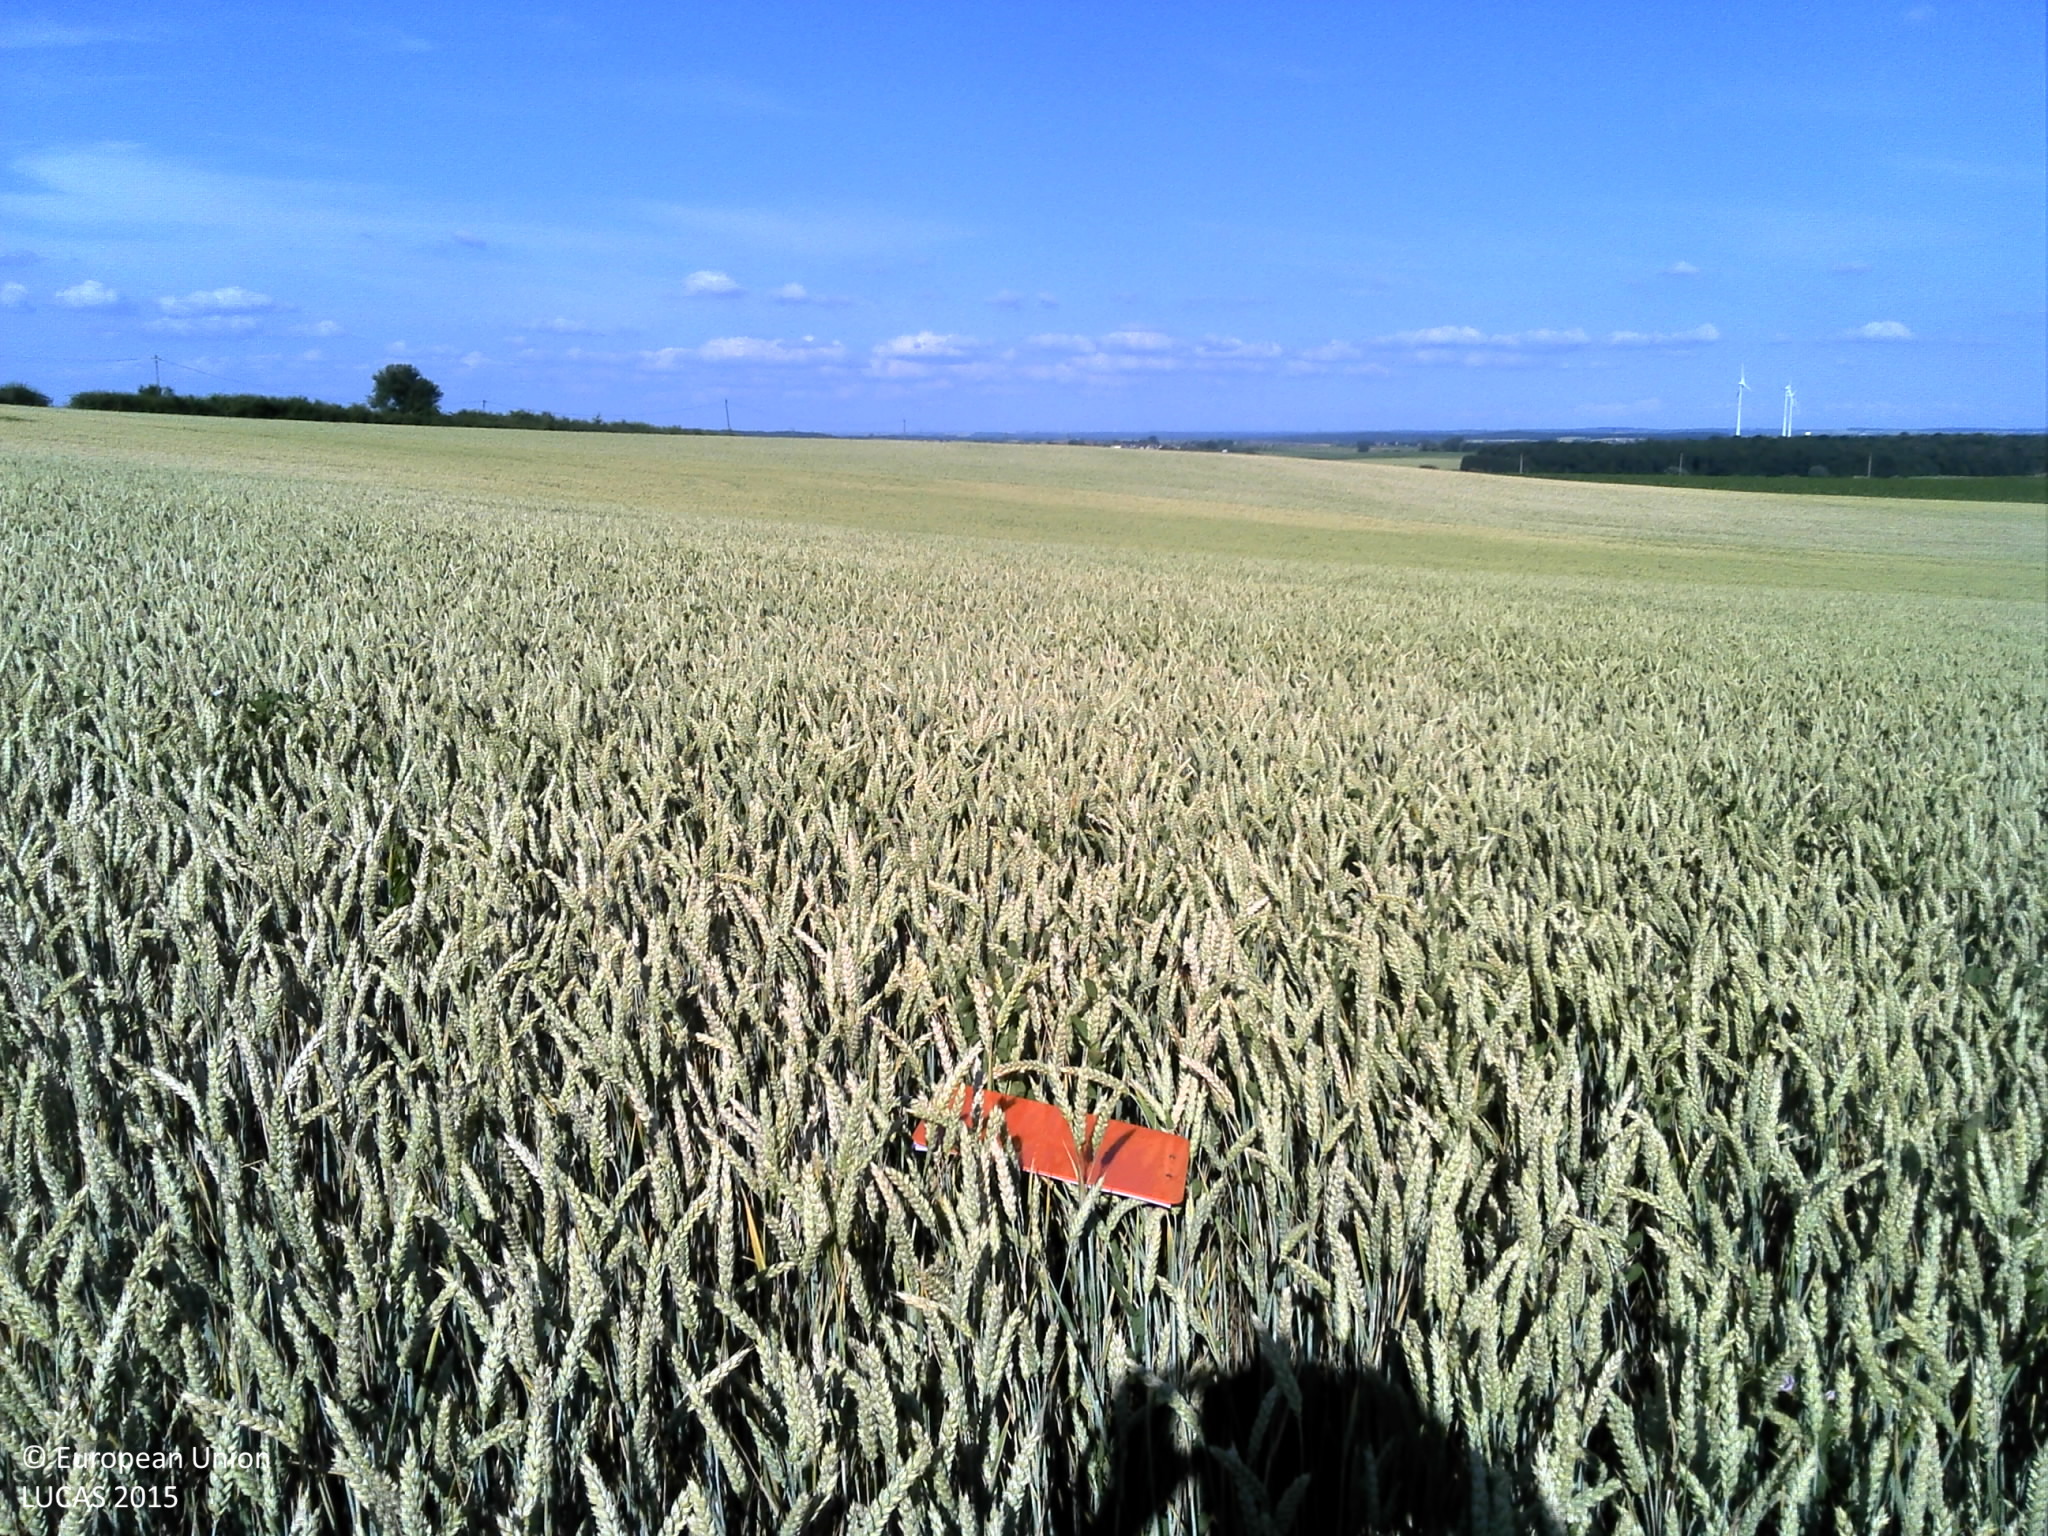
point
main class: Cropland
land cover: Common wheat
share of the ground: > 75 %
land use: Agriculture (excluding fallow land and kitchen gardens)
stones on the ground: 10 - 25 %
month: June
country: FR
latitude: 48.9879
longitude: 6.8163
